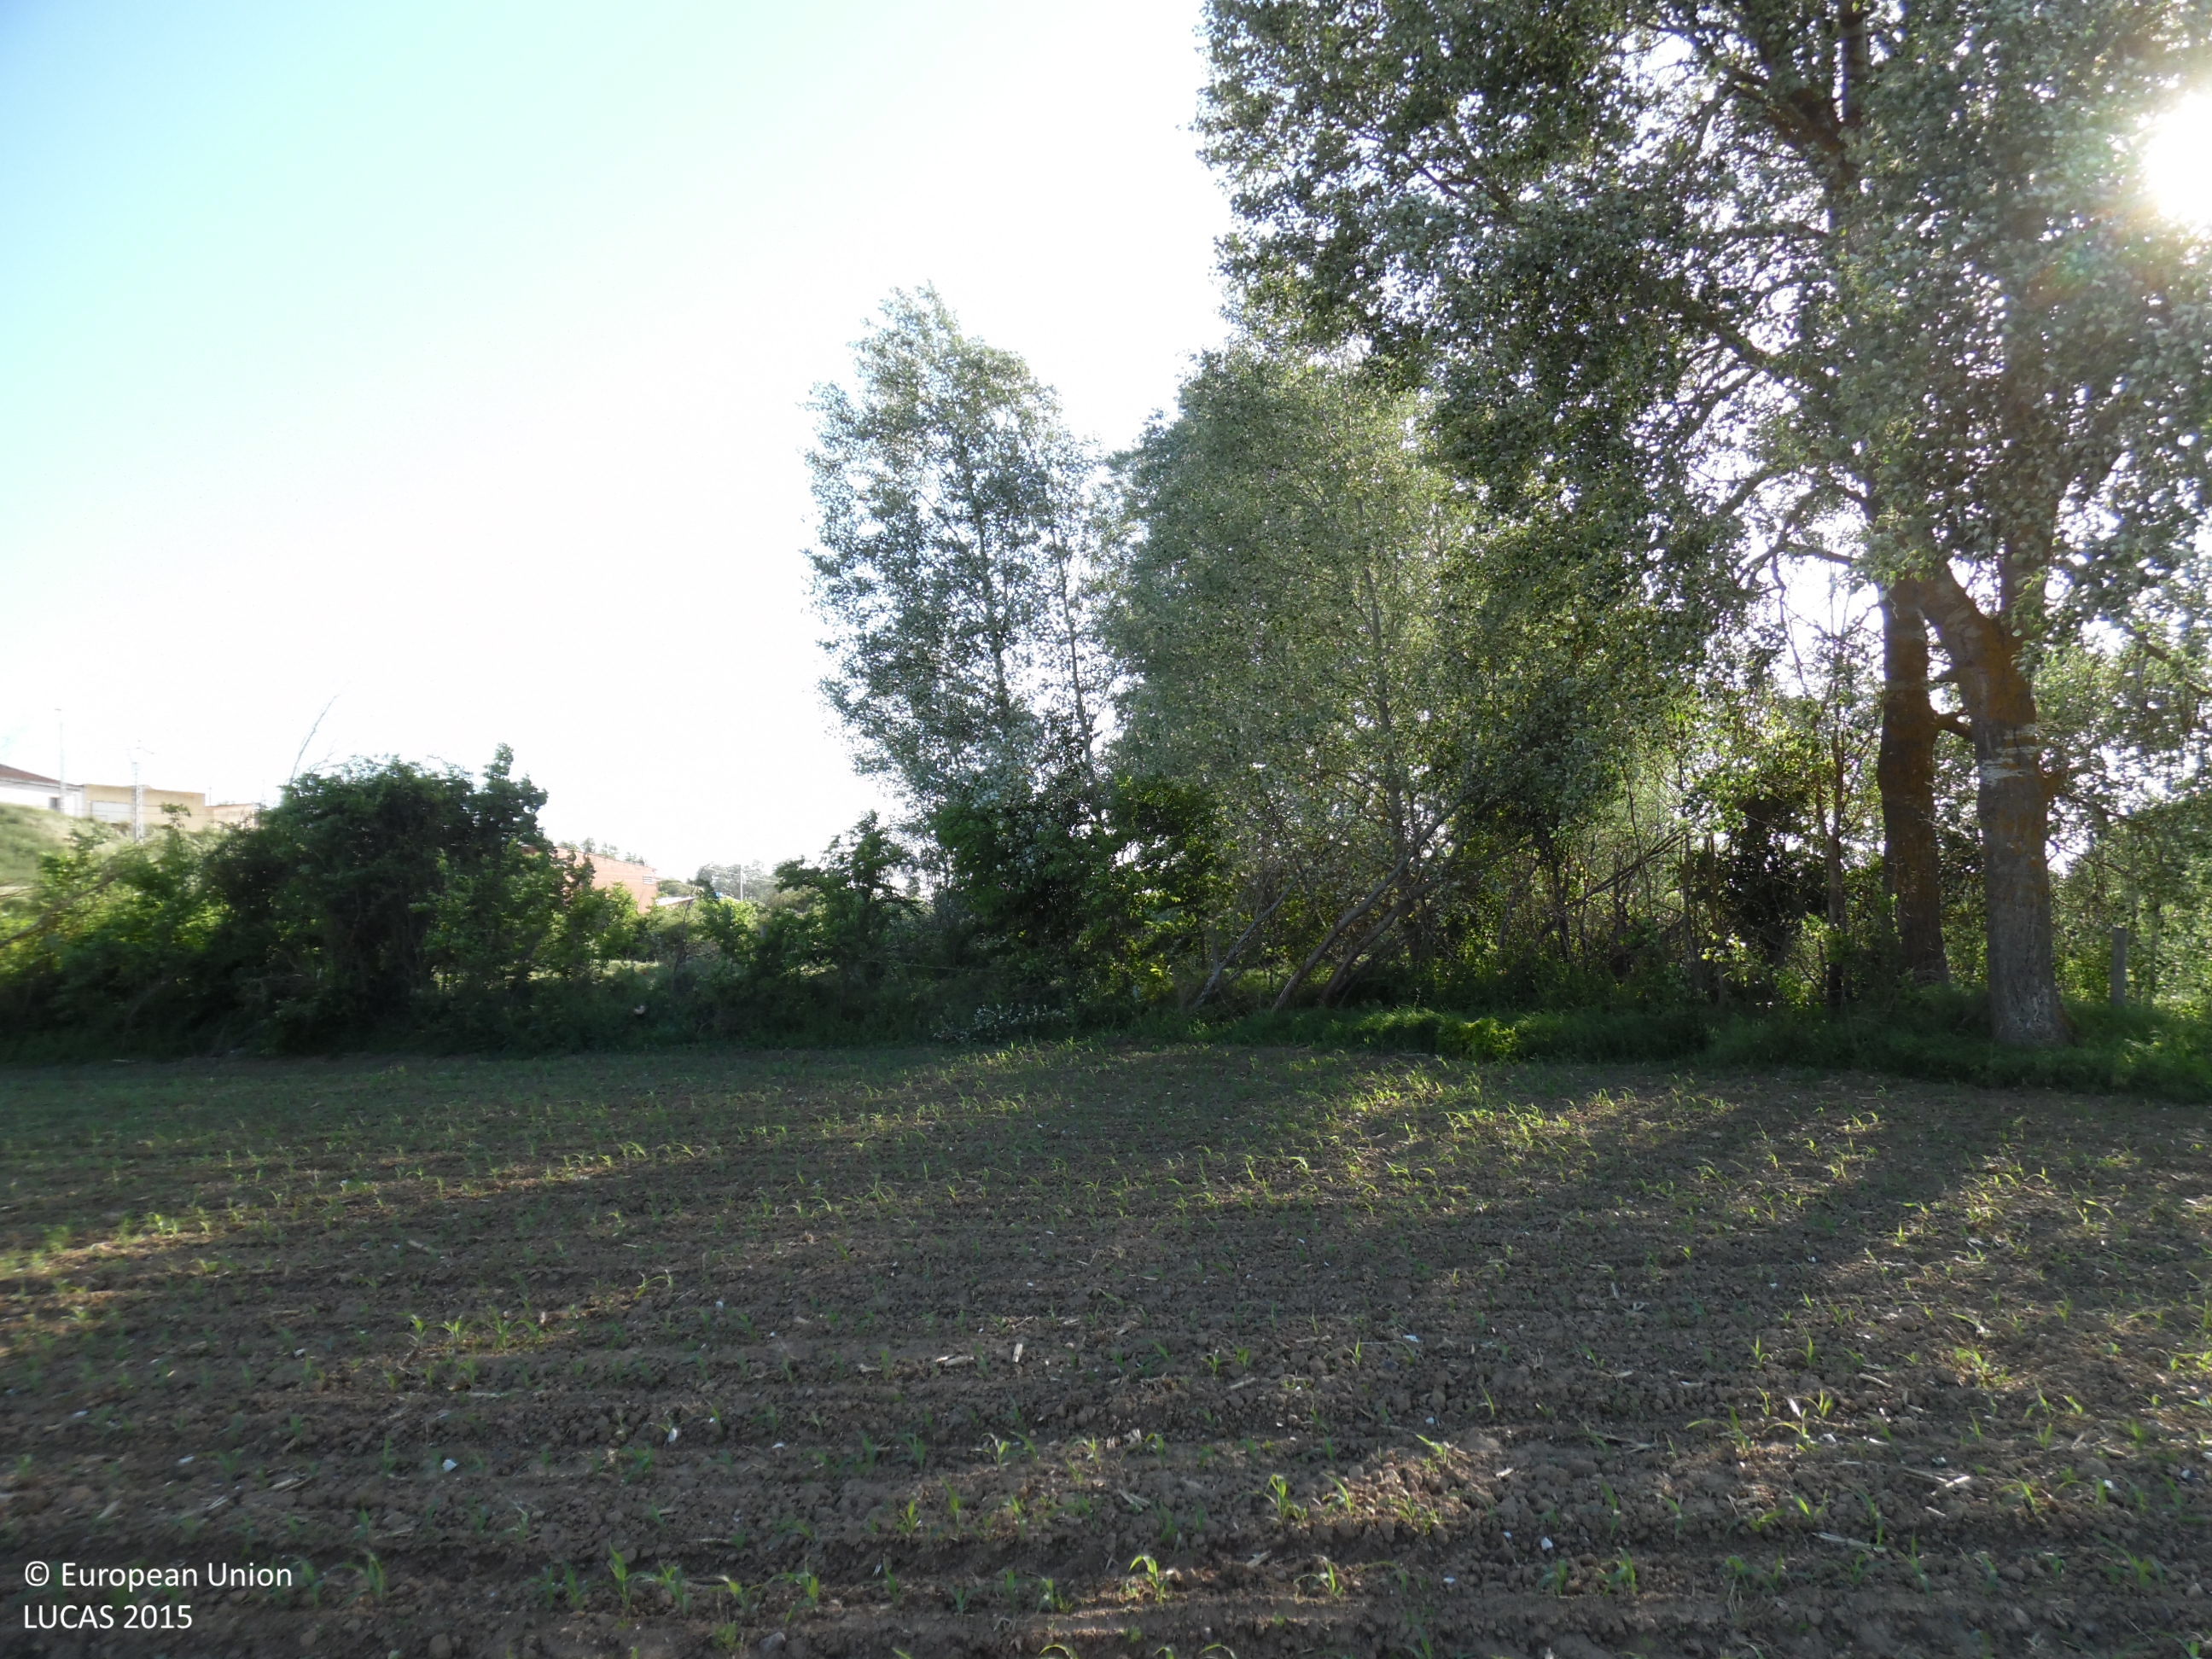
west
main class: Cropland
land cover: Maize
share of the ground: < 10 %
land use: Agriculture (excluding fallow land and kitchen gardens)
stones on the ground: < 10 %
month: May
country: ES
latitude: 42.1776
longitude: -5.6751
